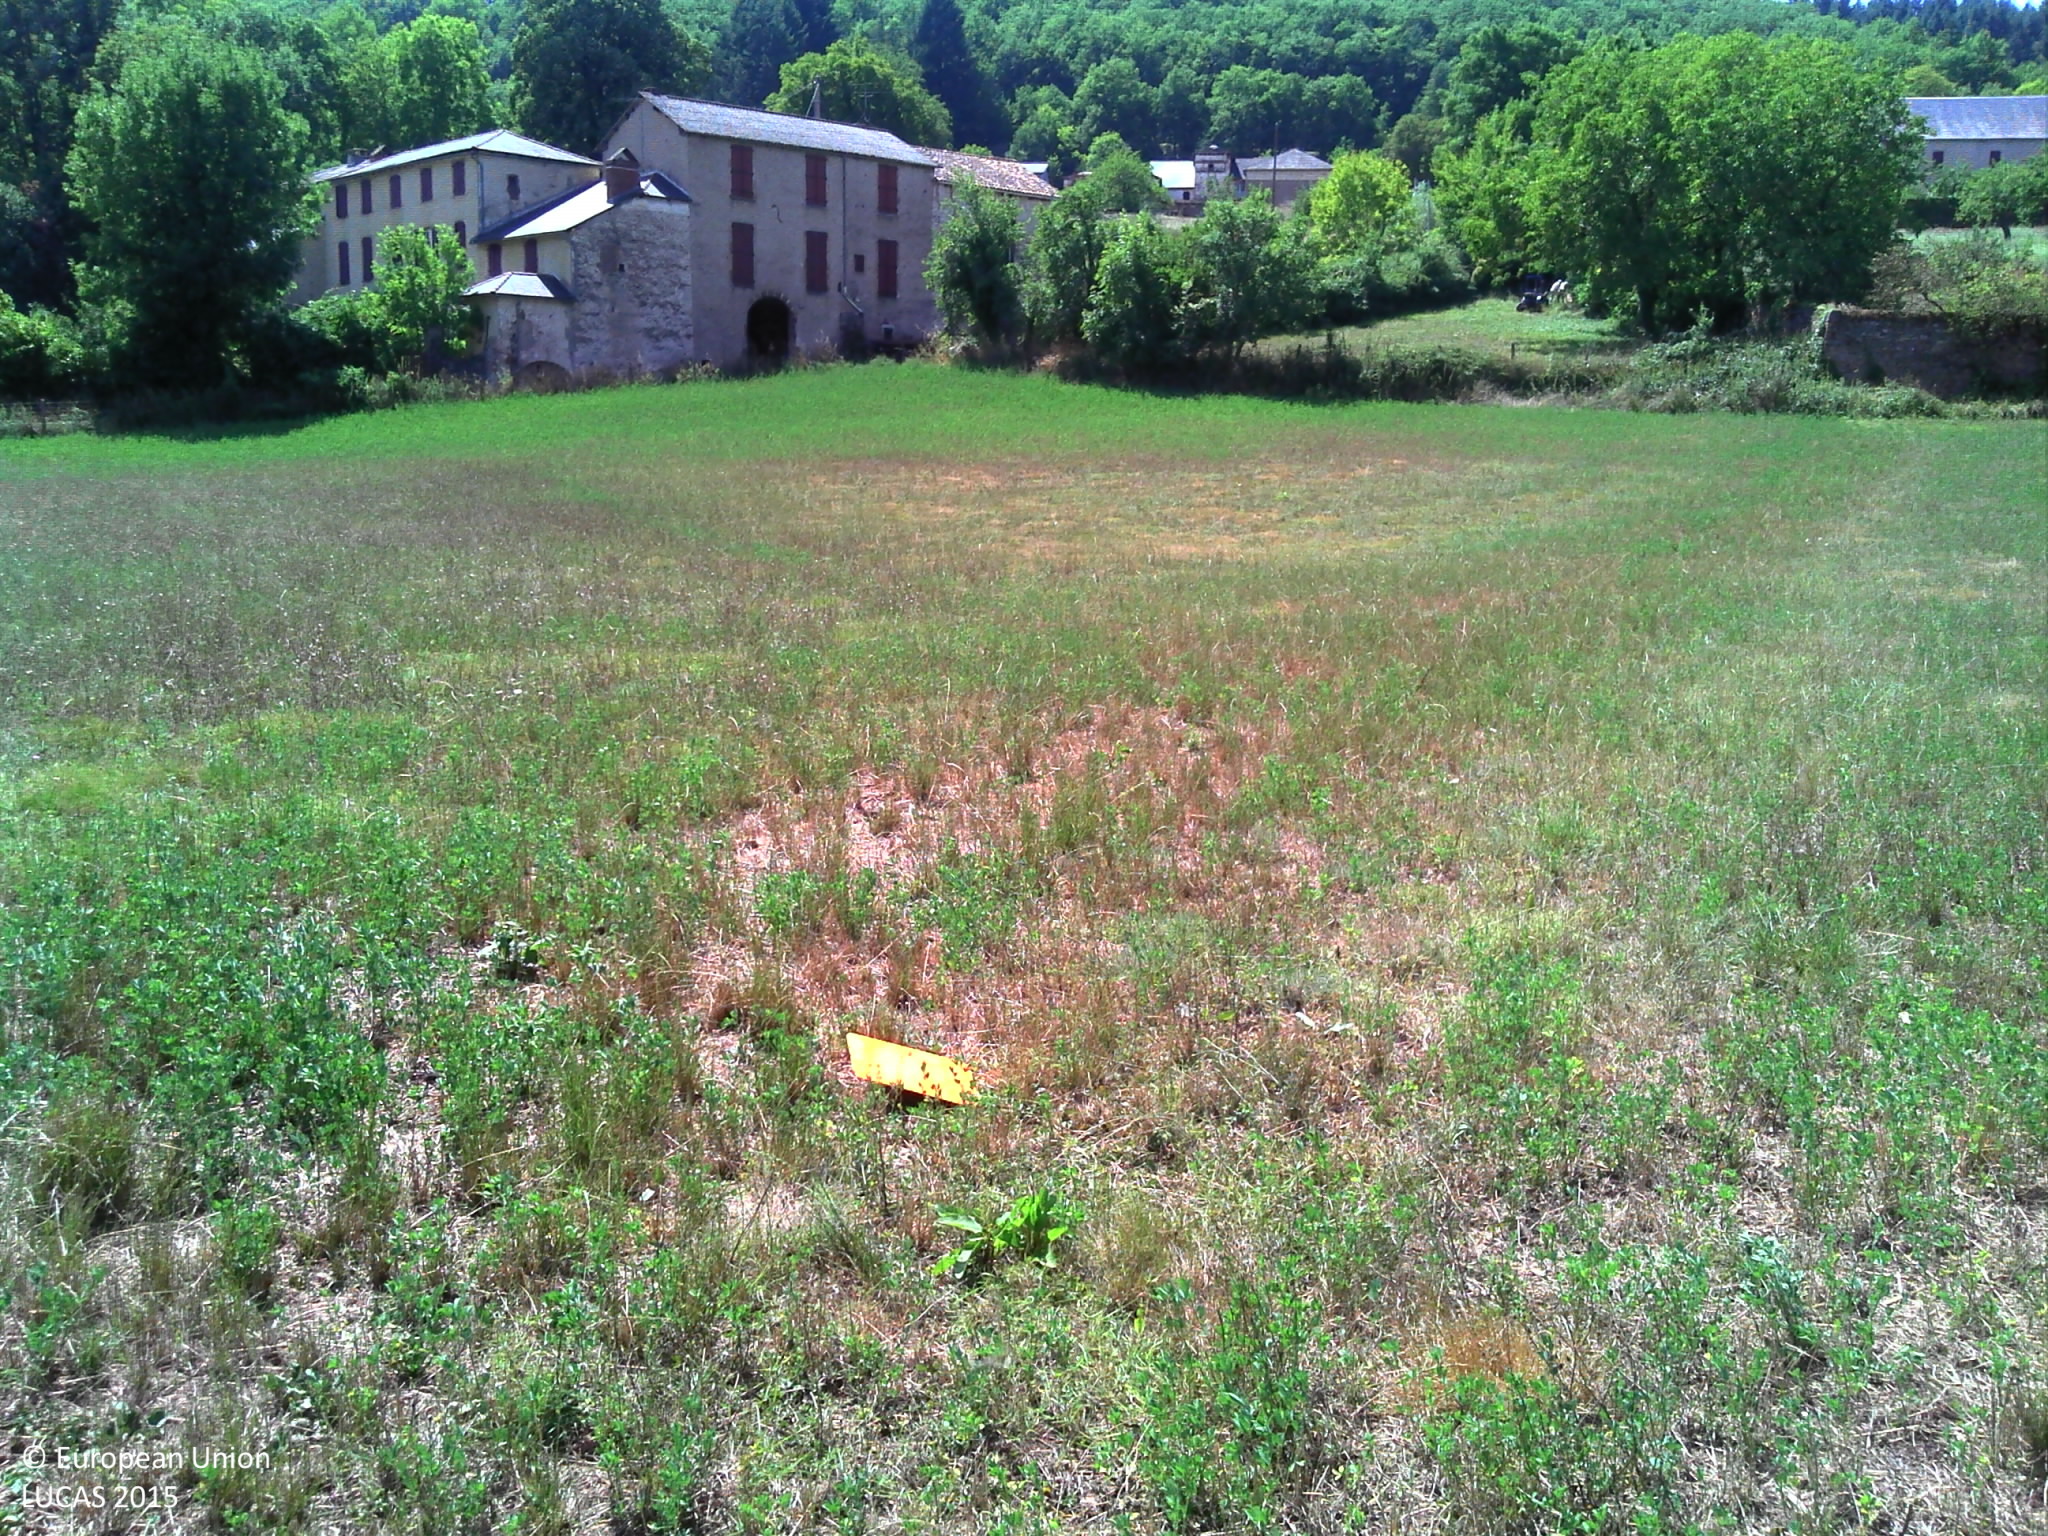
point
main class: Cropland
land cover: Temporary grasslands
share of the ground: > 75 %
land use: Agriculture (excluding fallow land and kitchen gardens)
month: August
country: FR
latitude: 43.8528
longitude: 2.6288
